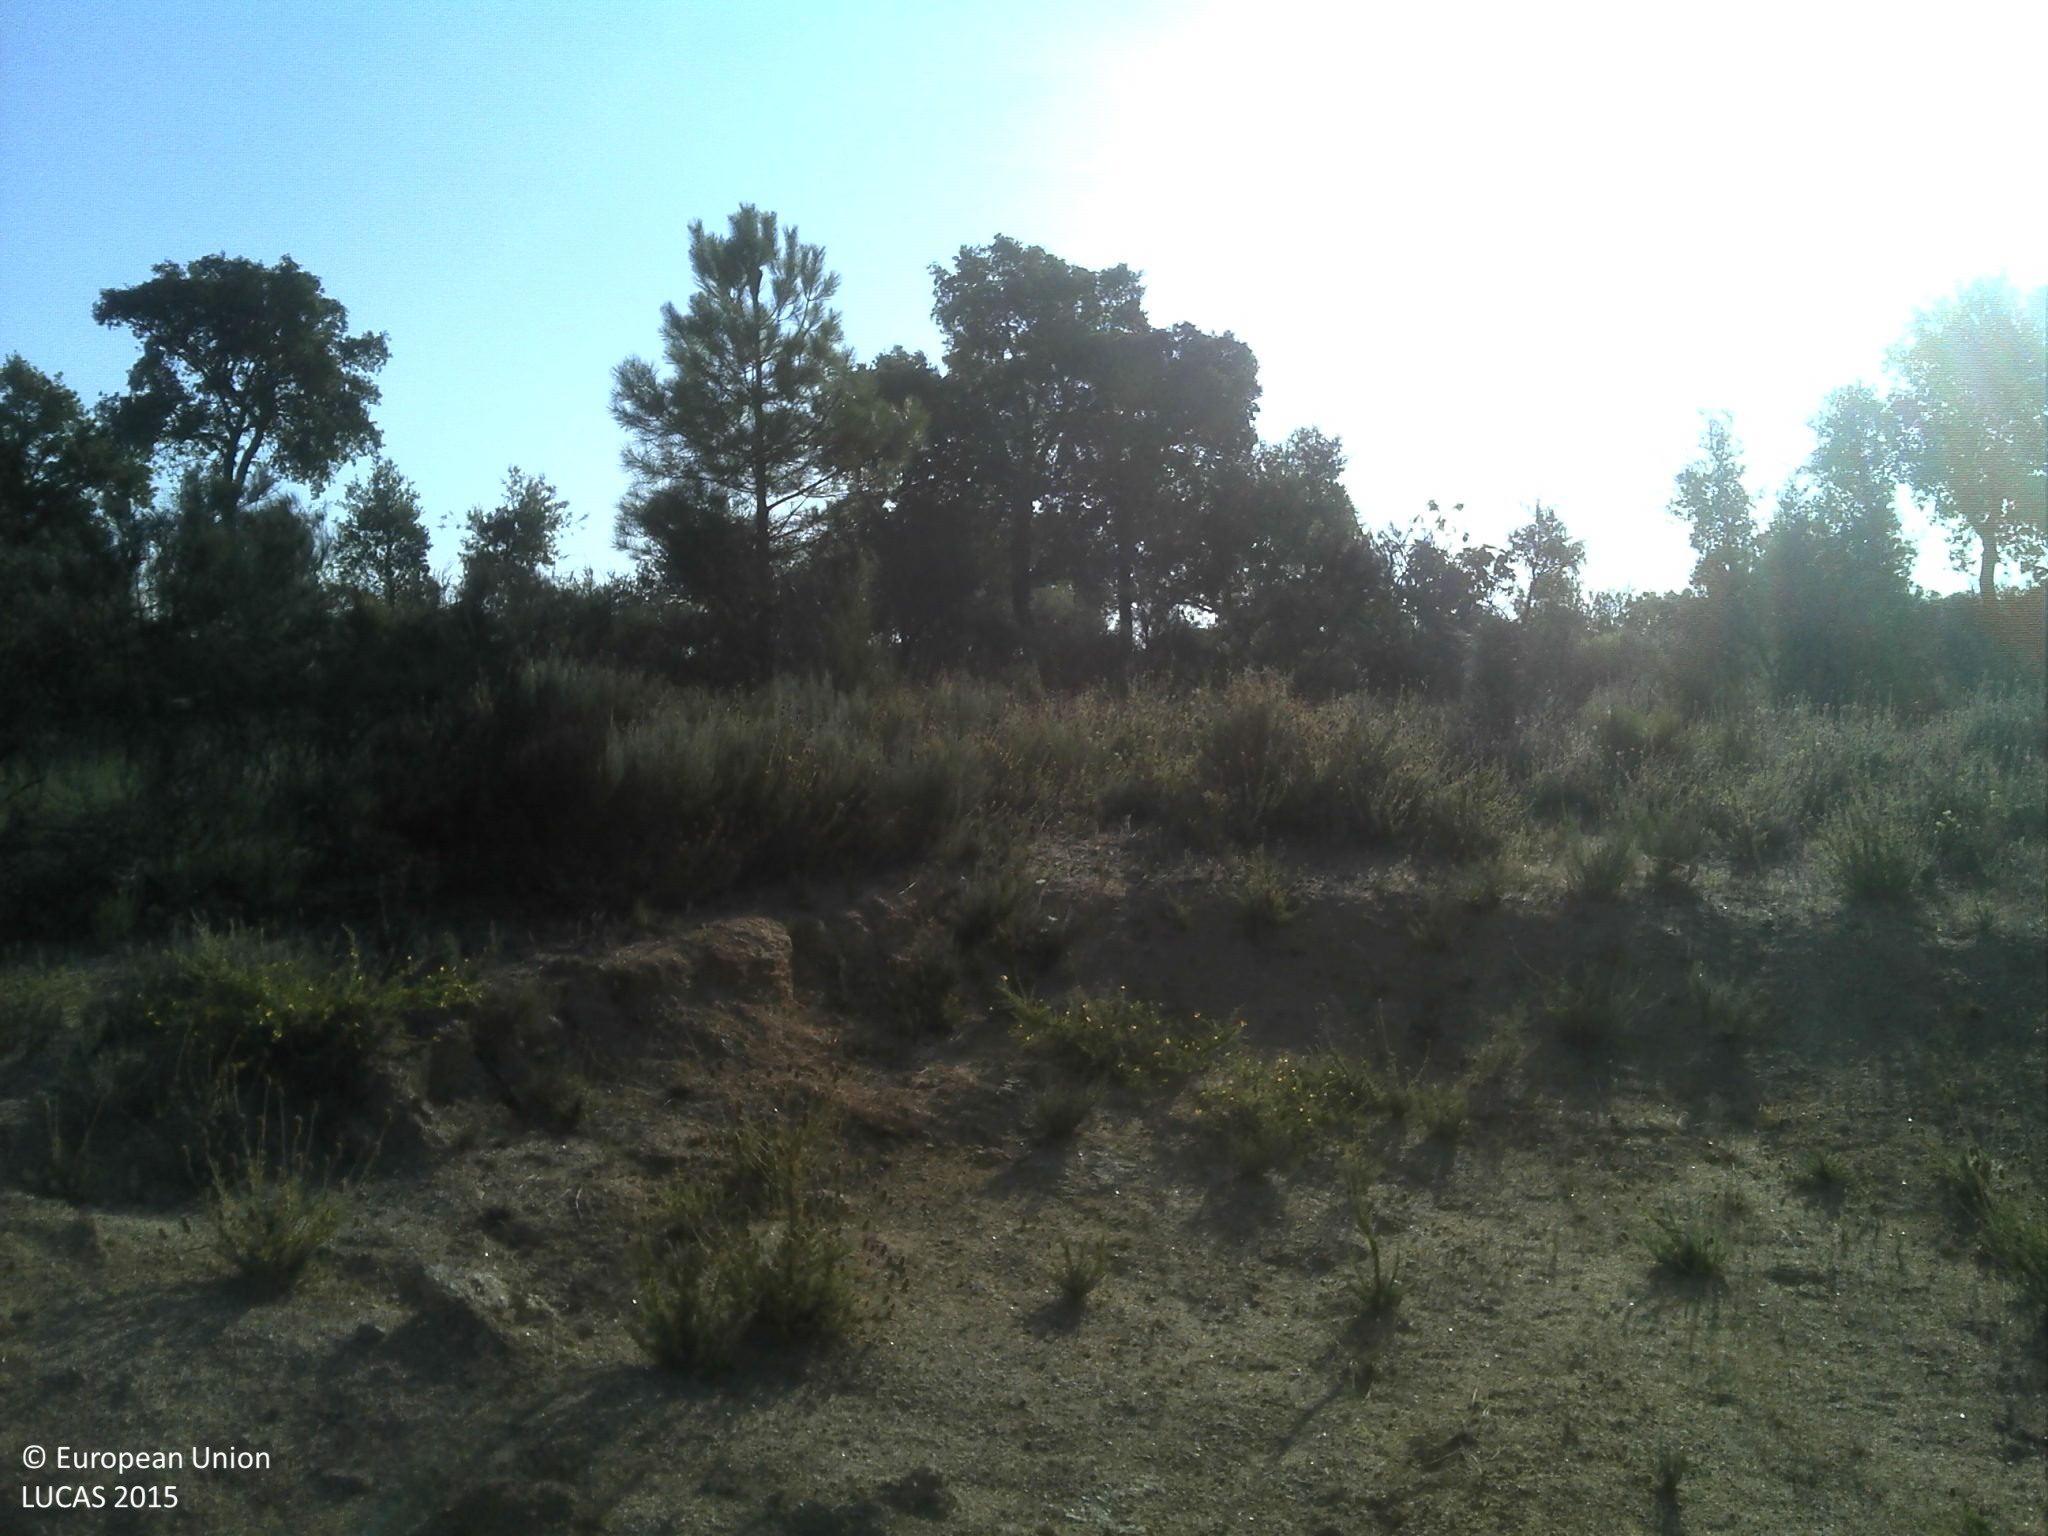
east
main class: Shrubland
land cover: Shrubland without tree cover
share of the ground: 50 - 75 %
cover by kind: shrubs 50 %, herbaceous plants 35 %, unconsolidated bare surface 10 %
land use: Forestry
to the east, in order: Shrubland without tree cover; Shrubland with sparse tree cover; Dry stone walls; Olive groves; Dry stone walls; Olive groves; Broadleaved woodland; Olive groves; Dry stone walls; Shrubland with sparse tree cover; Dry stone walls; Shrubland with sparse tree cover; Grassland without tree/shrub cover; Dry stone walls; Grassland with sparse tree/shrub cover; Dry stone walls; Shrubland with sparse tree cover; Rivers and streams; Shrubland with sparse tree cover; Rocks and stones; Shrubland with sparse tree cover; Dry stone walls; Fences; Rocks and stones; Broadleaved woodland
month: June
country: PT
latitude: 40.0268
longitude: -7.0957
